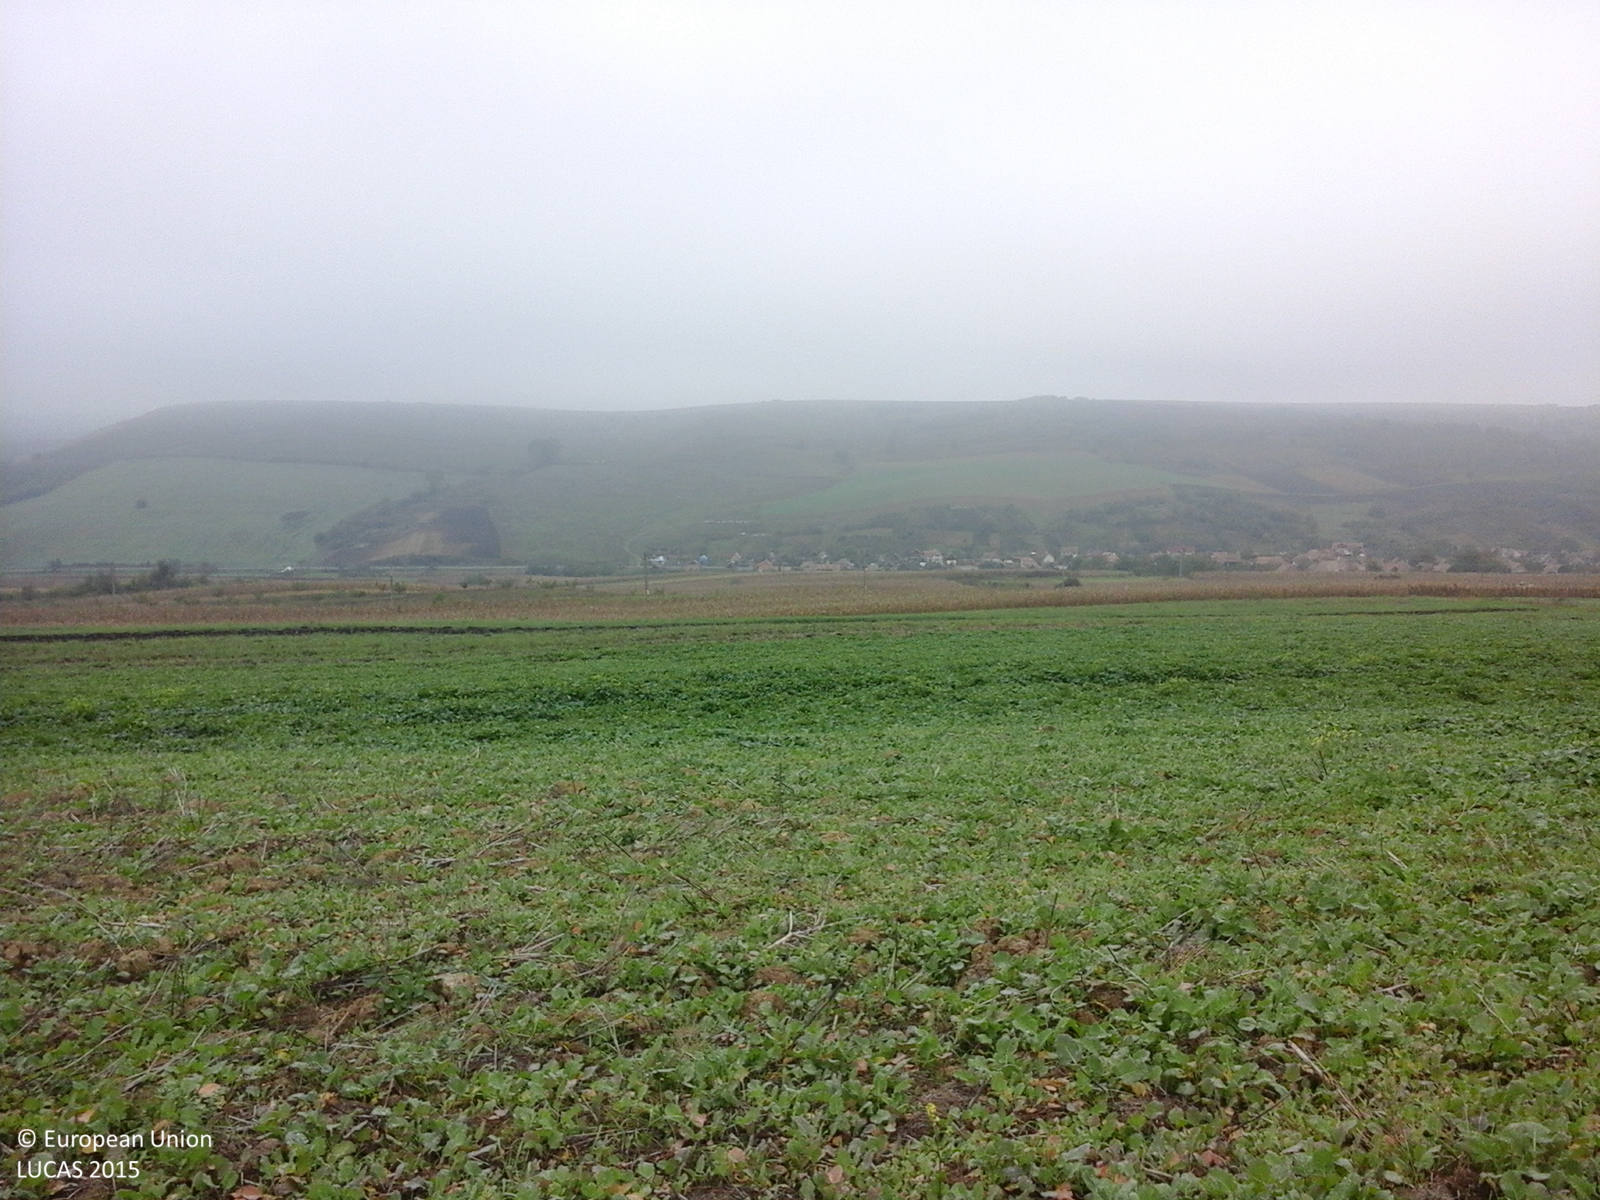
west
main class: Cropland
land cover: Rape and turnip rape
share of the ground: > 75 %
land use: Agriculture (excluding fallow land and kitchen gardens)
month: October
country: RO
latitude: 46.3938
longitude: 24.2698
